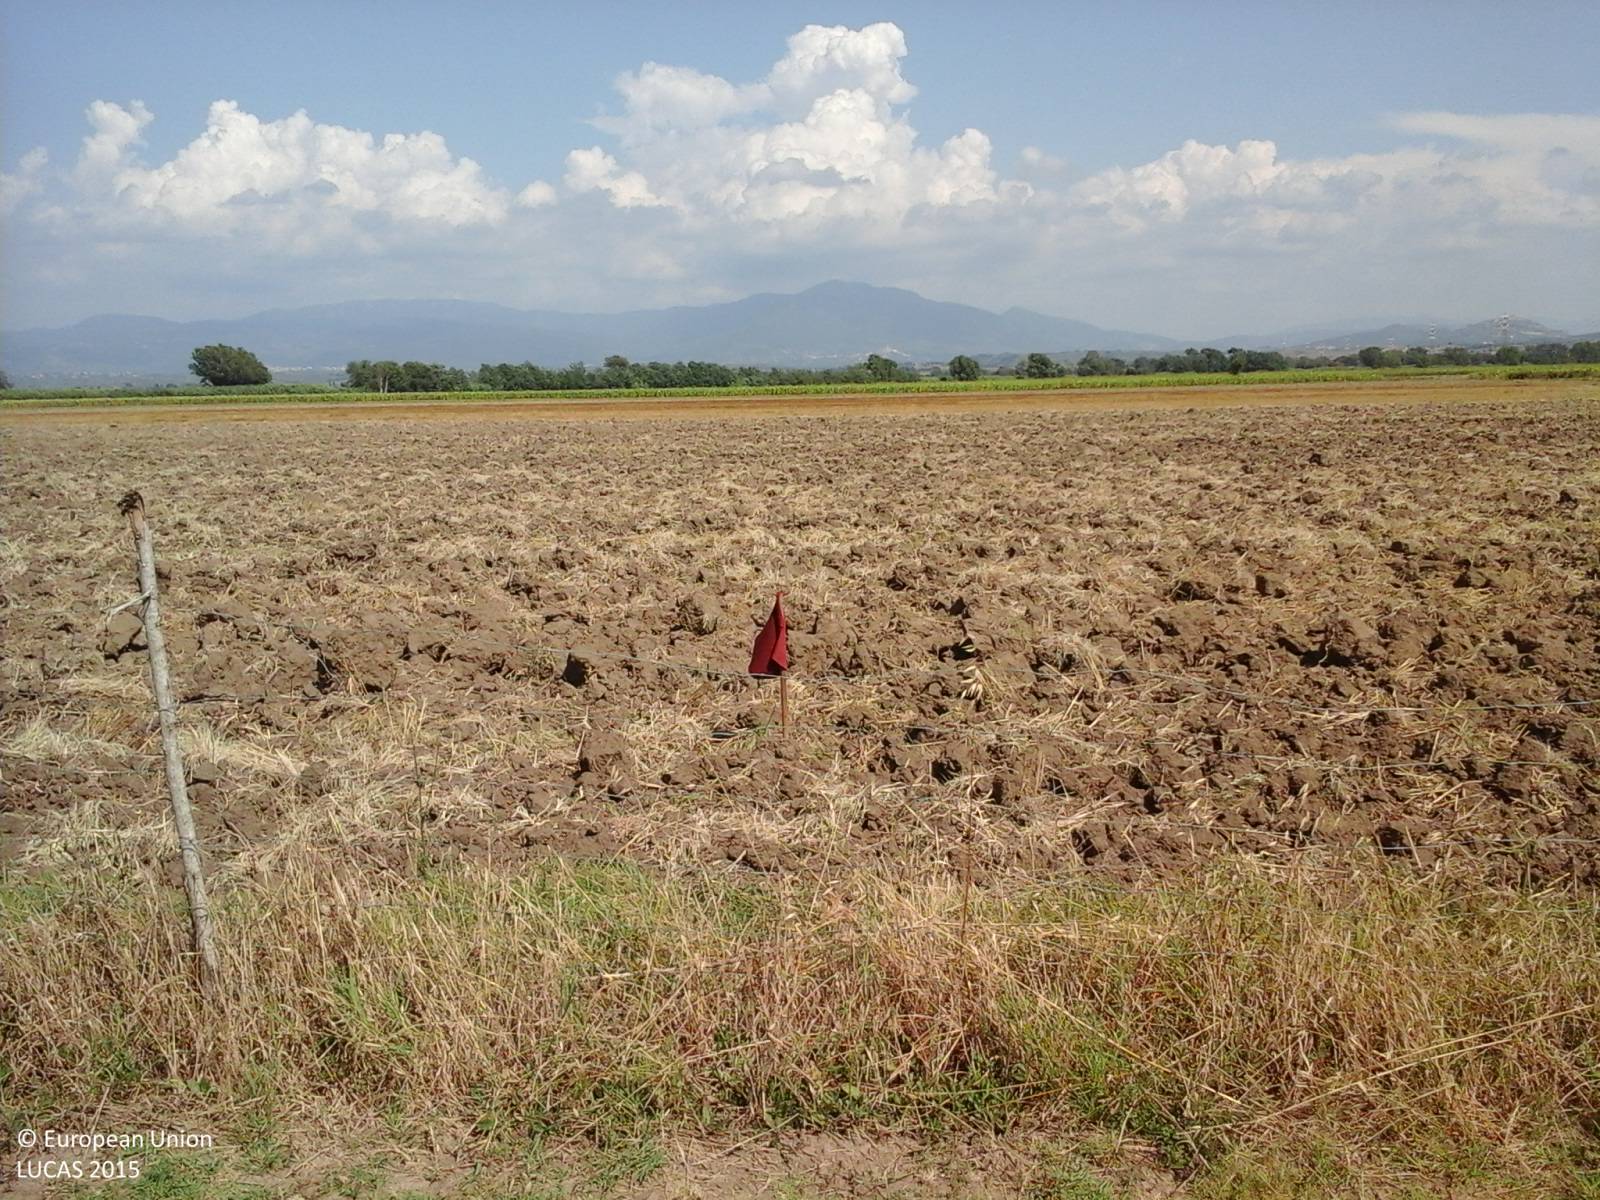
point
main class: Cropland
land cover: Durum wheat
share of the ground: < 10 %
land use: Agriculture (excluding fallow land and kitchen gardens)
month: July
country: IT
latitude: 42.1148
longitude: 12.5911
